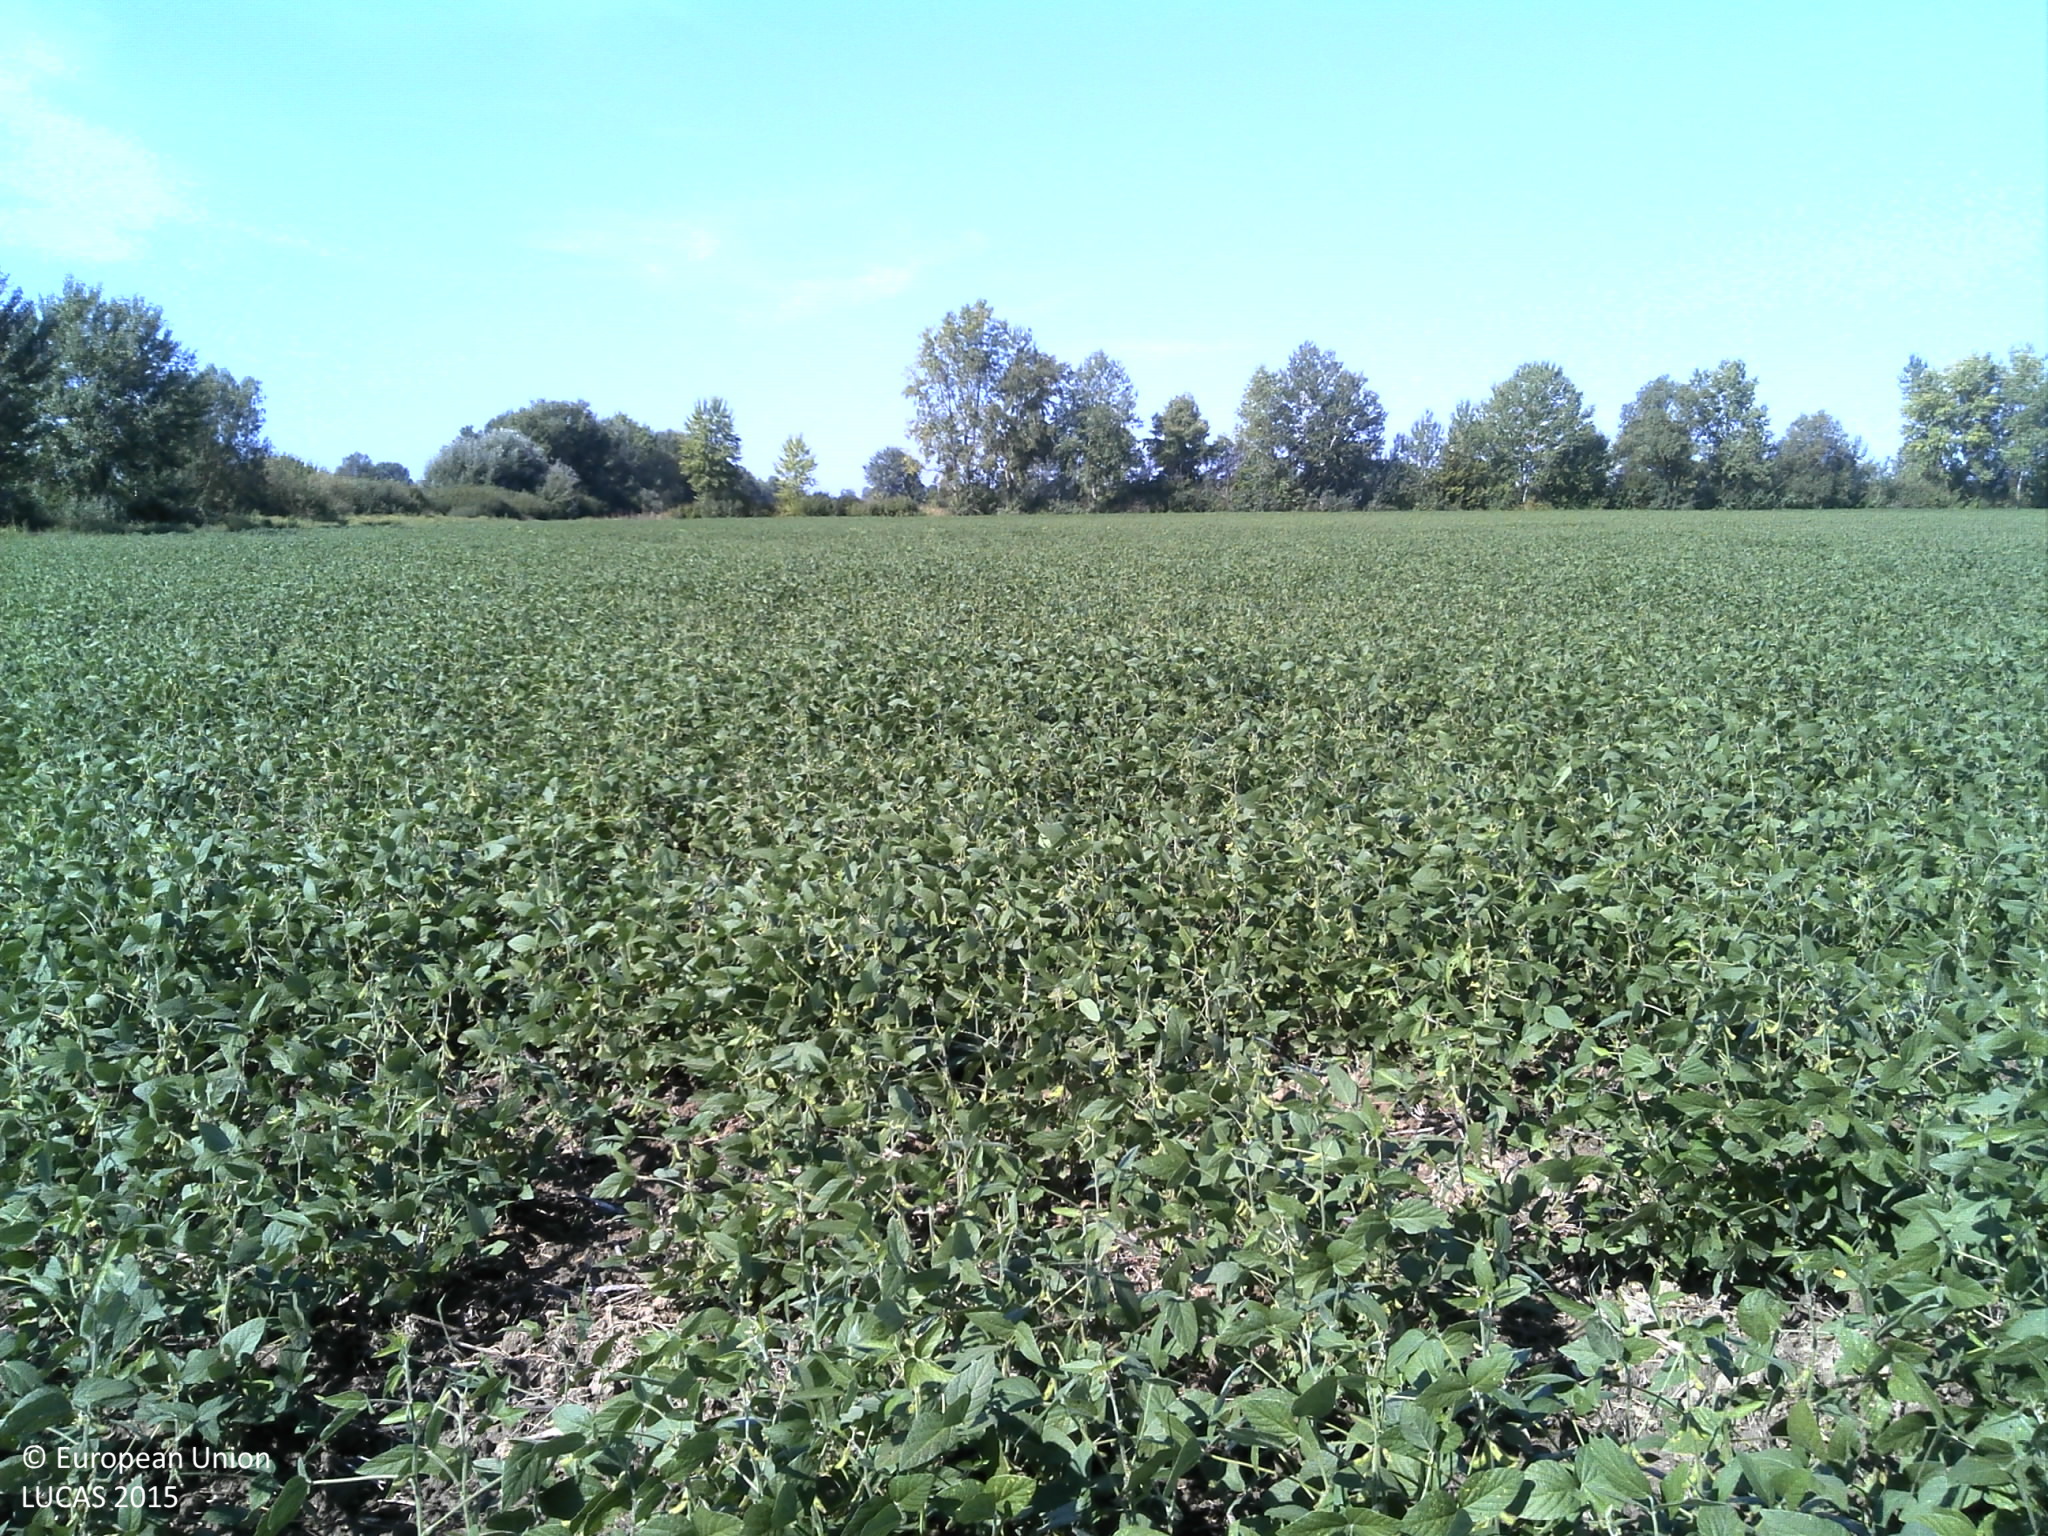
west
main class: Cropland
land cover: Soya
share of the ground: > 75 %
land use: Agriculture (excluding fallow land and kitchen gardens)
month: September
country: HR
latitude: 44.9209
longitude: 18.9886
